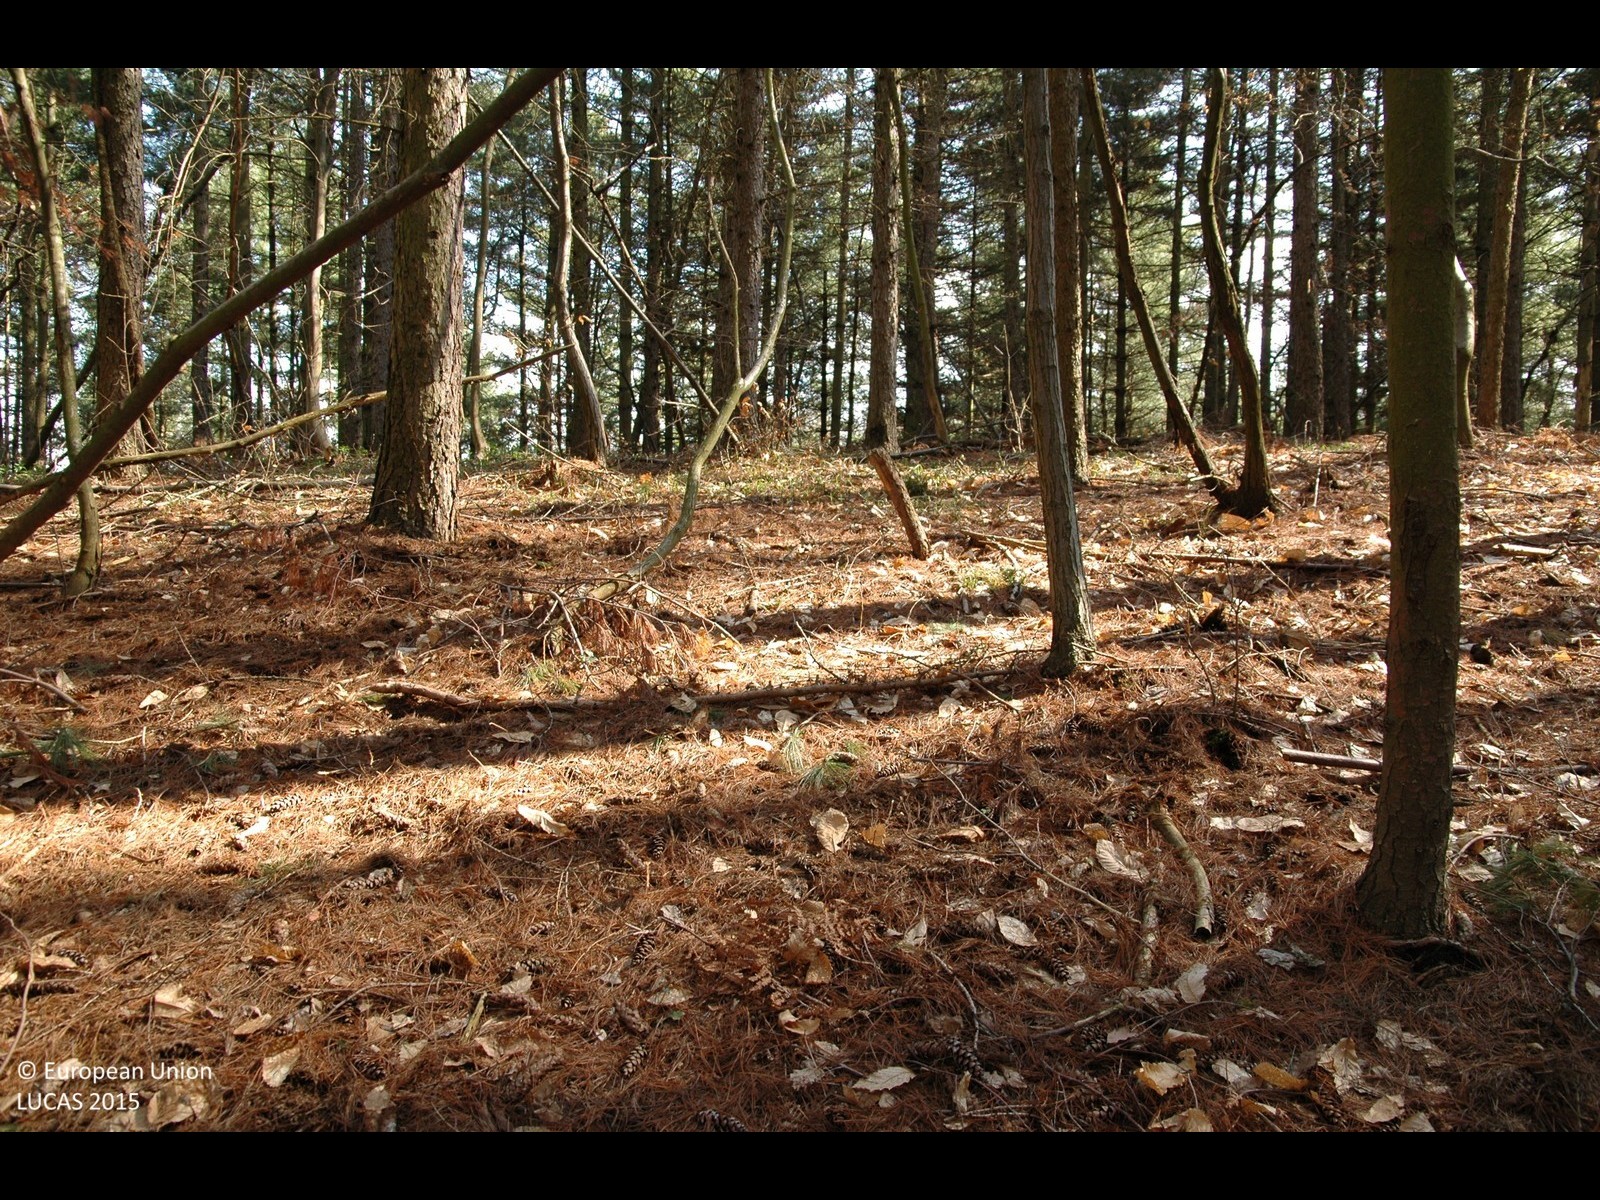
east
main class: Woodland
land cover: Pine dominated coniferous woodland
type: hemiboreal forest and nemoral coniferous forest and mixed broadleaved-coniferous forest
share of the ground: > 75 %
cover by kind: coniferous forest trees 95 %, broadleaved forest trees 5 %
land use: Forestry
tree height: > 5 m
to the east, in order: Pine dominated coniferous woodland; Broadleaved woodland; Pine dominated coniferous woodland
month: March
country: HR
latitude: 46.3371
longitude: 16.1447
